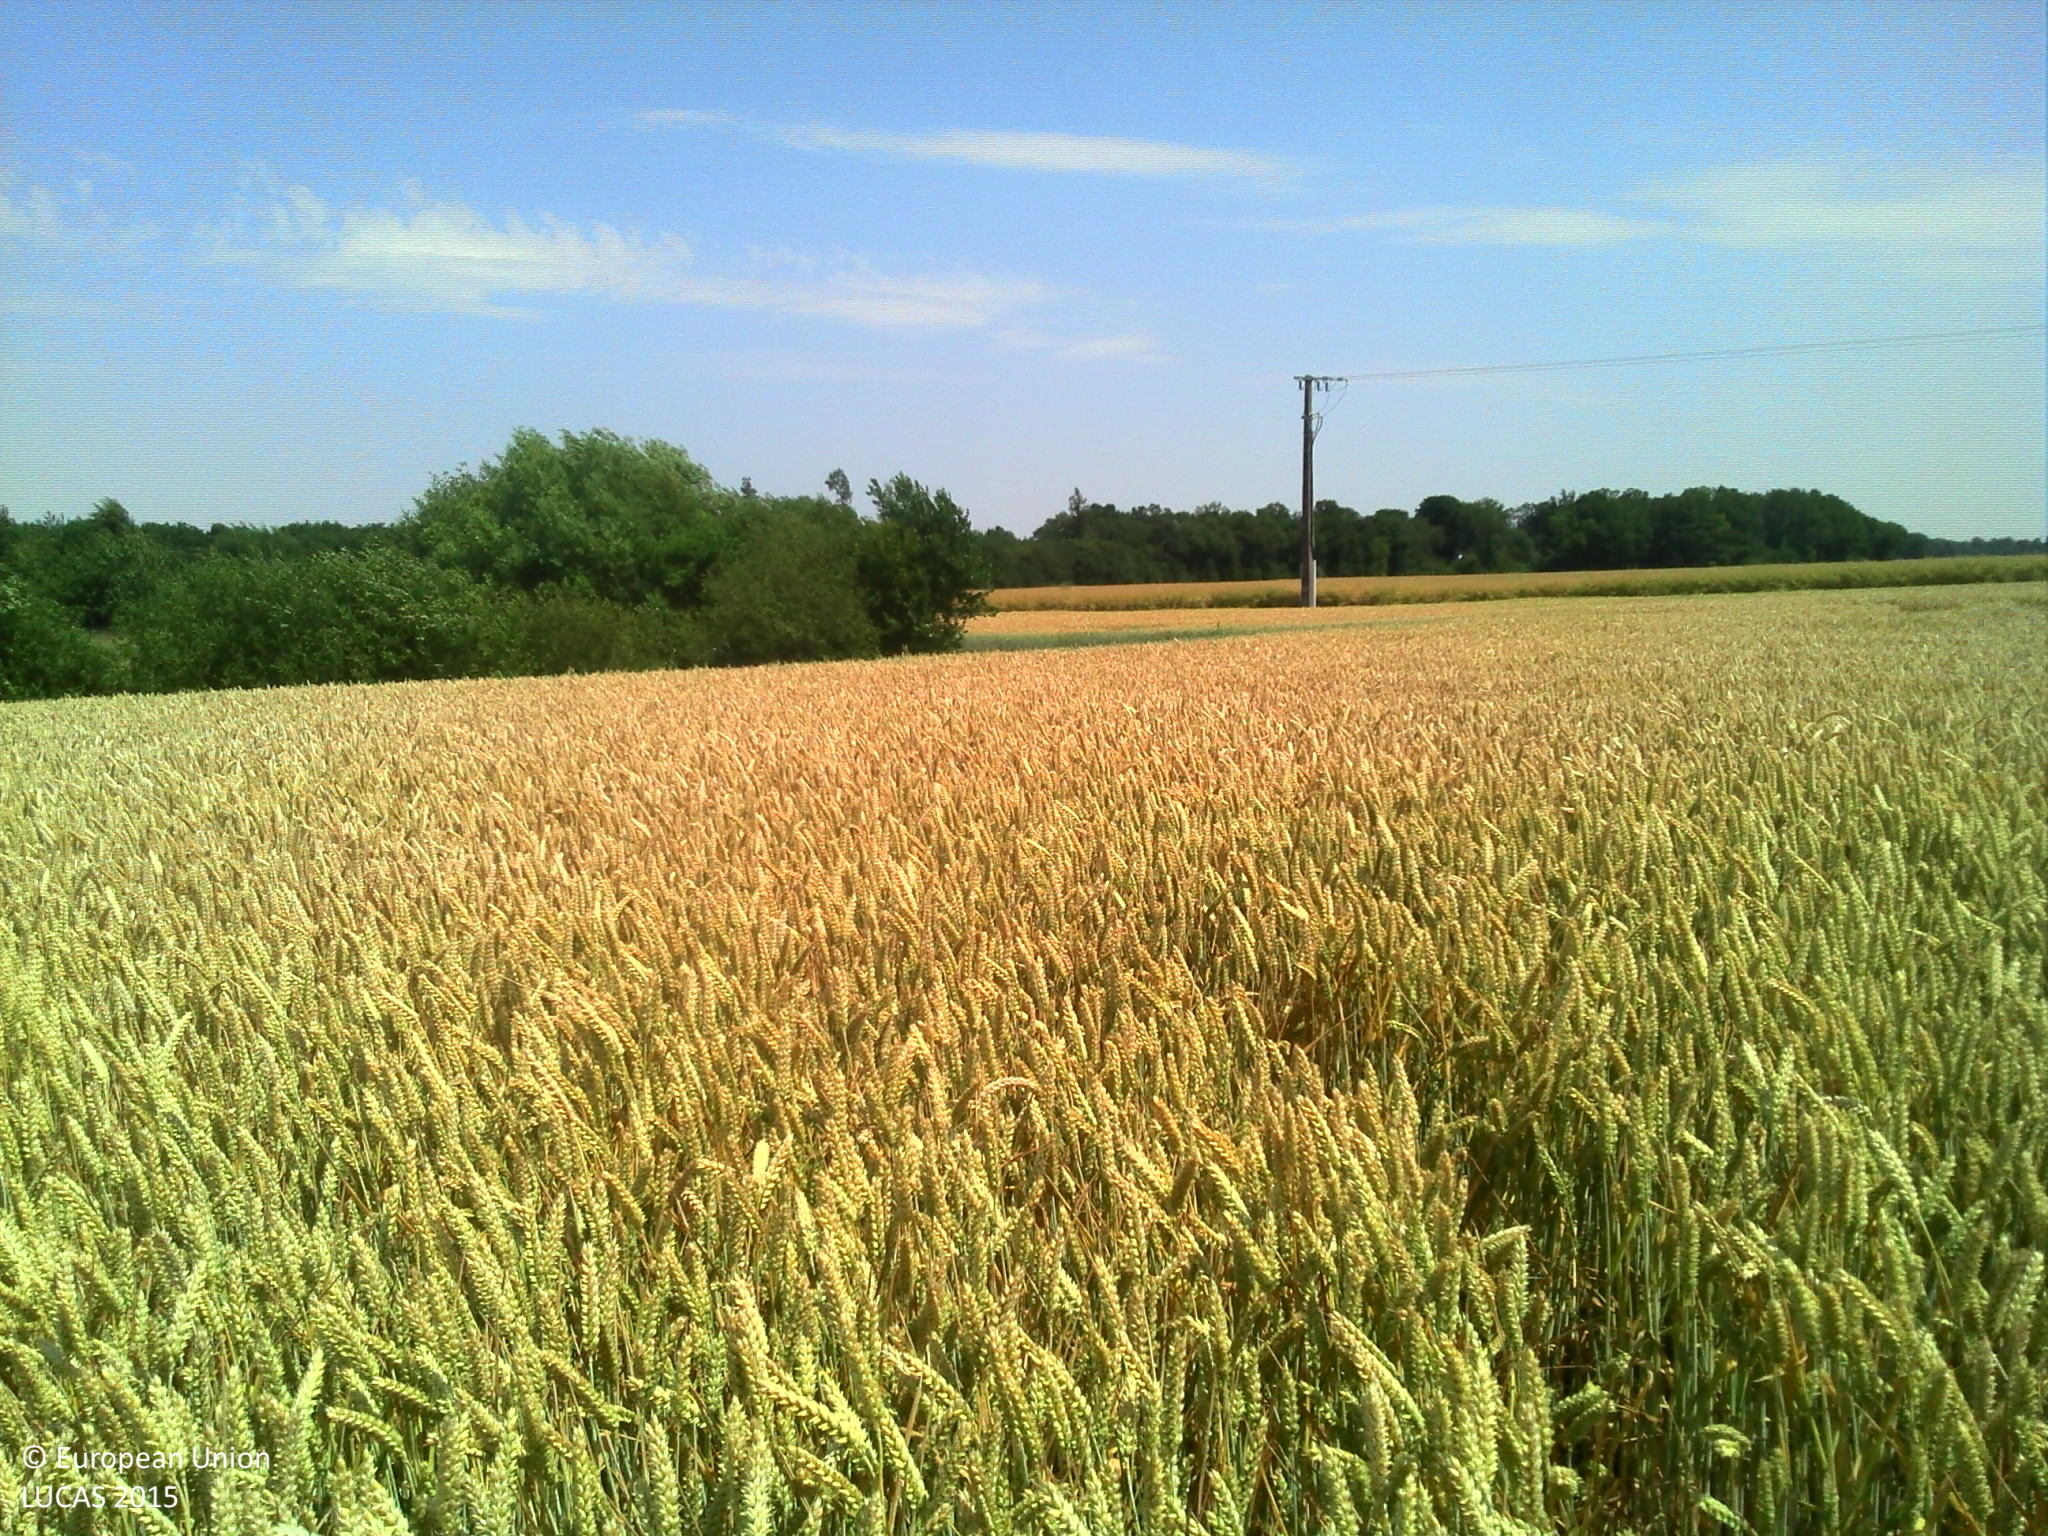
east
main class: Cropland
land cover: Common wheat
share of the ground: > 75 %
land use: Agriculture (excluding fallow land and kitchen gardens)
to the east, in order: Common wheat; Grassland without tree/shrub cover; Inland fresh water bodies; Single bushes/trees; Grassland without tree/shrub cover; Common wheat; Paved roads, cycling and walking lanes; Grass margins; Rape and turnip rape; Broadleaved woodland
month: July
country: FR
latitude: 48.9454
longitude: 1.2832
